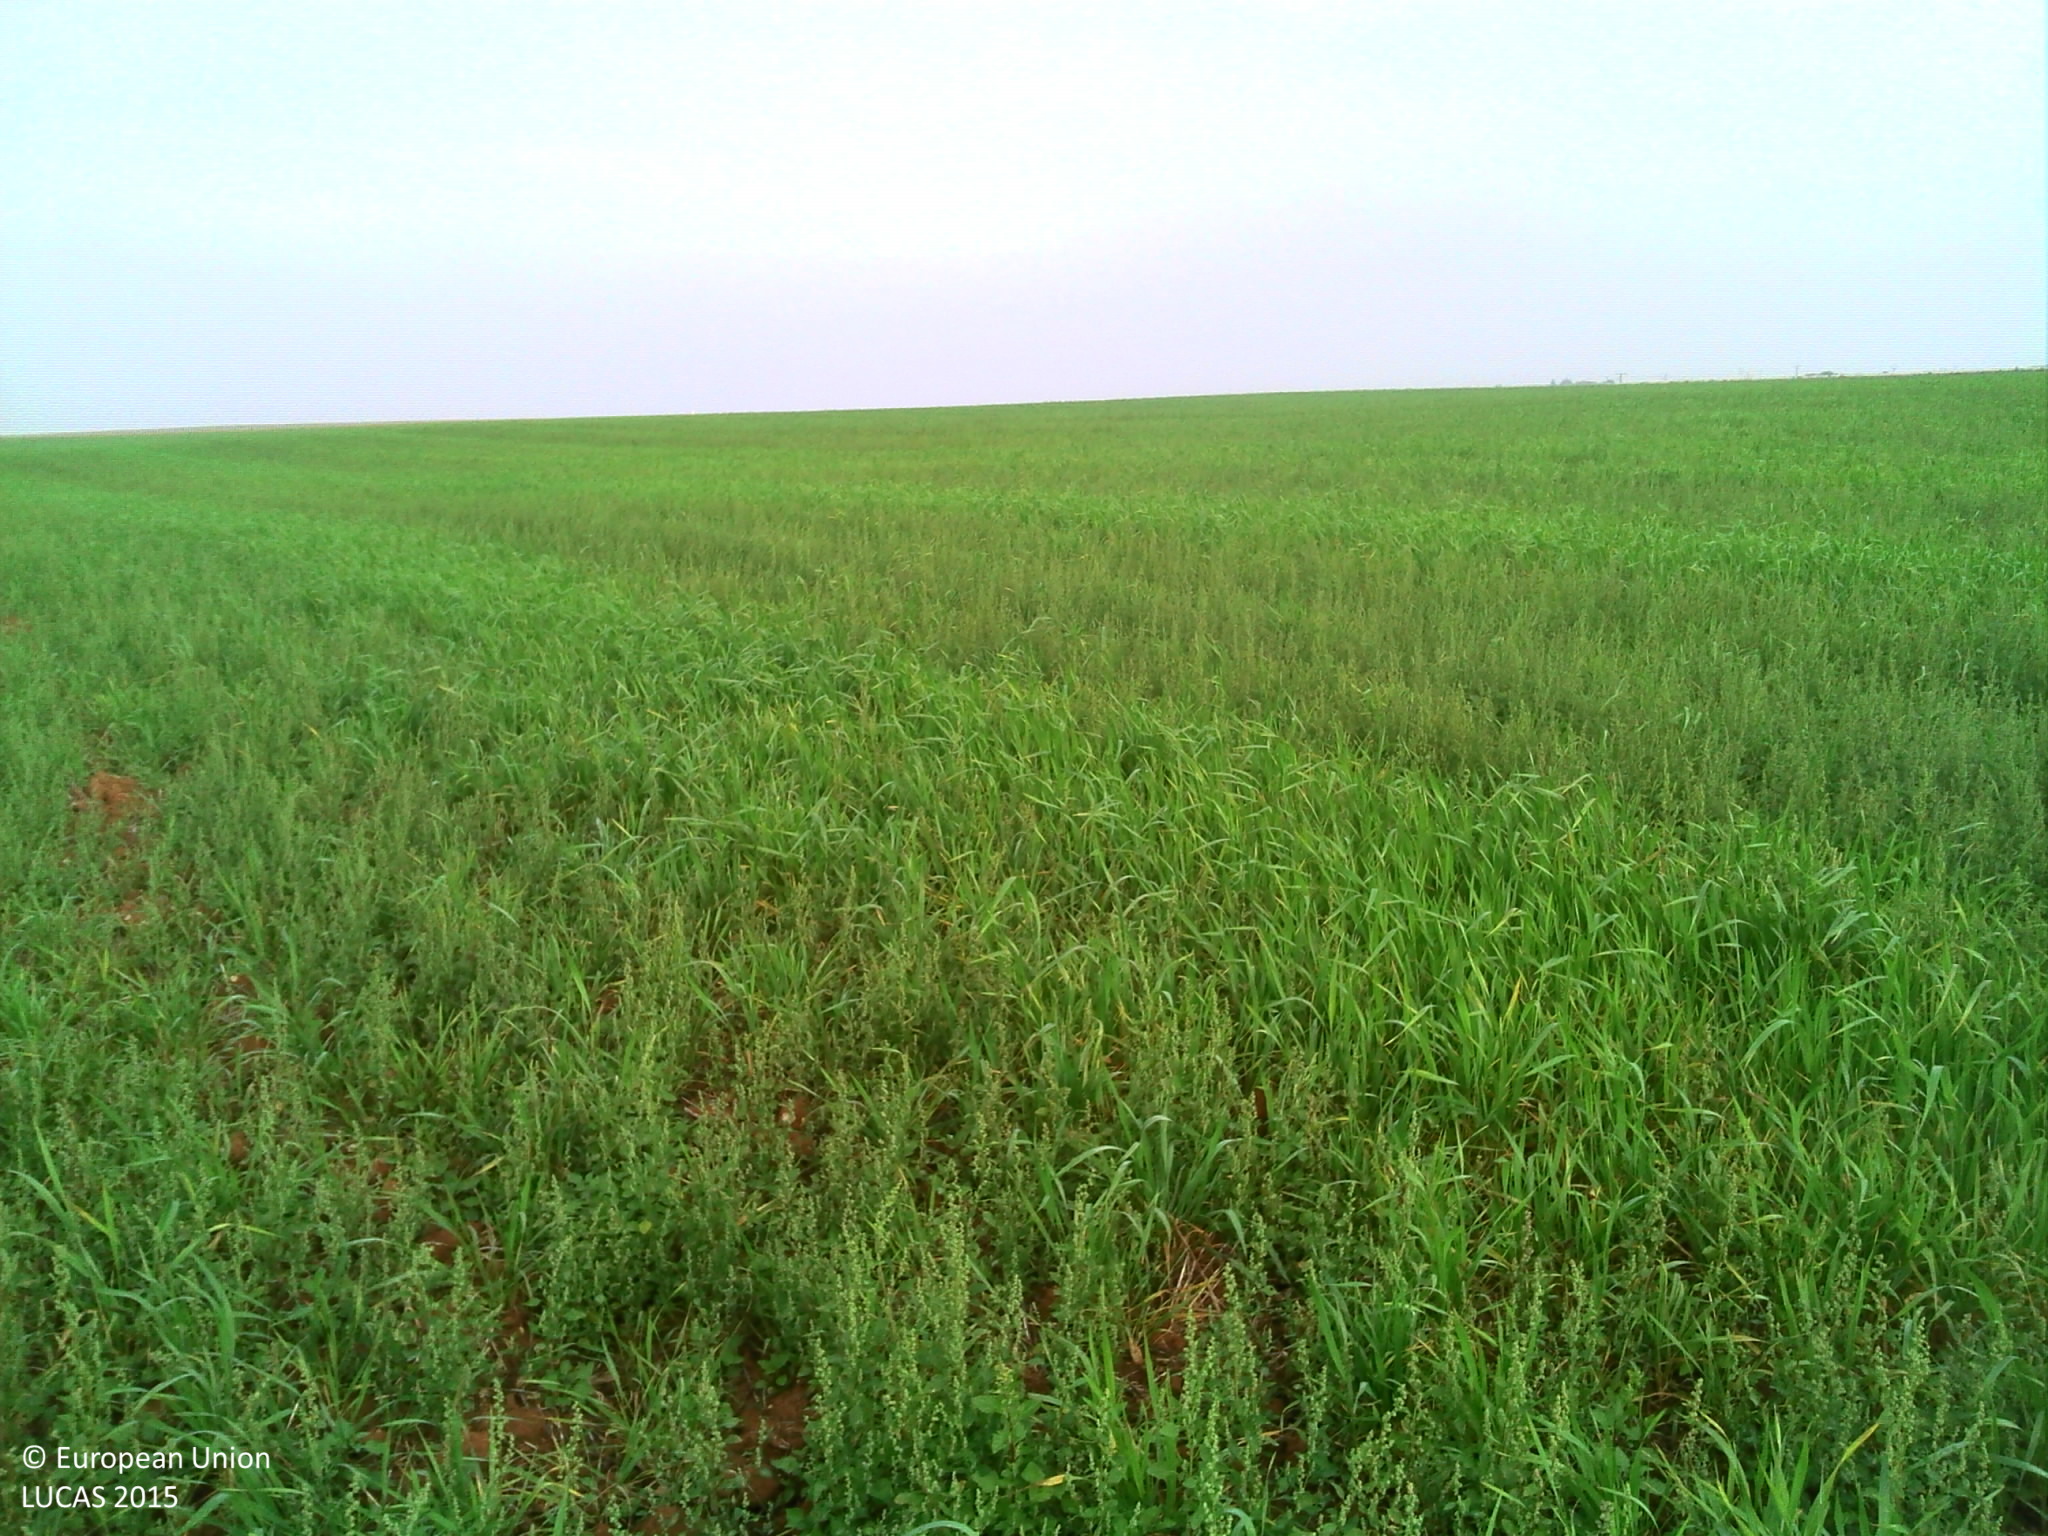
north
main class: Cropland
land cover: Common wheat
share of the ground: 25 - 50 %
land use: Agriculture (excluding fallow land and kitchen gardens)
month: October
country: FR
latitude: 46.4892
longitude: -1.0143
